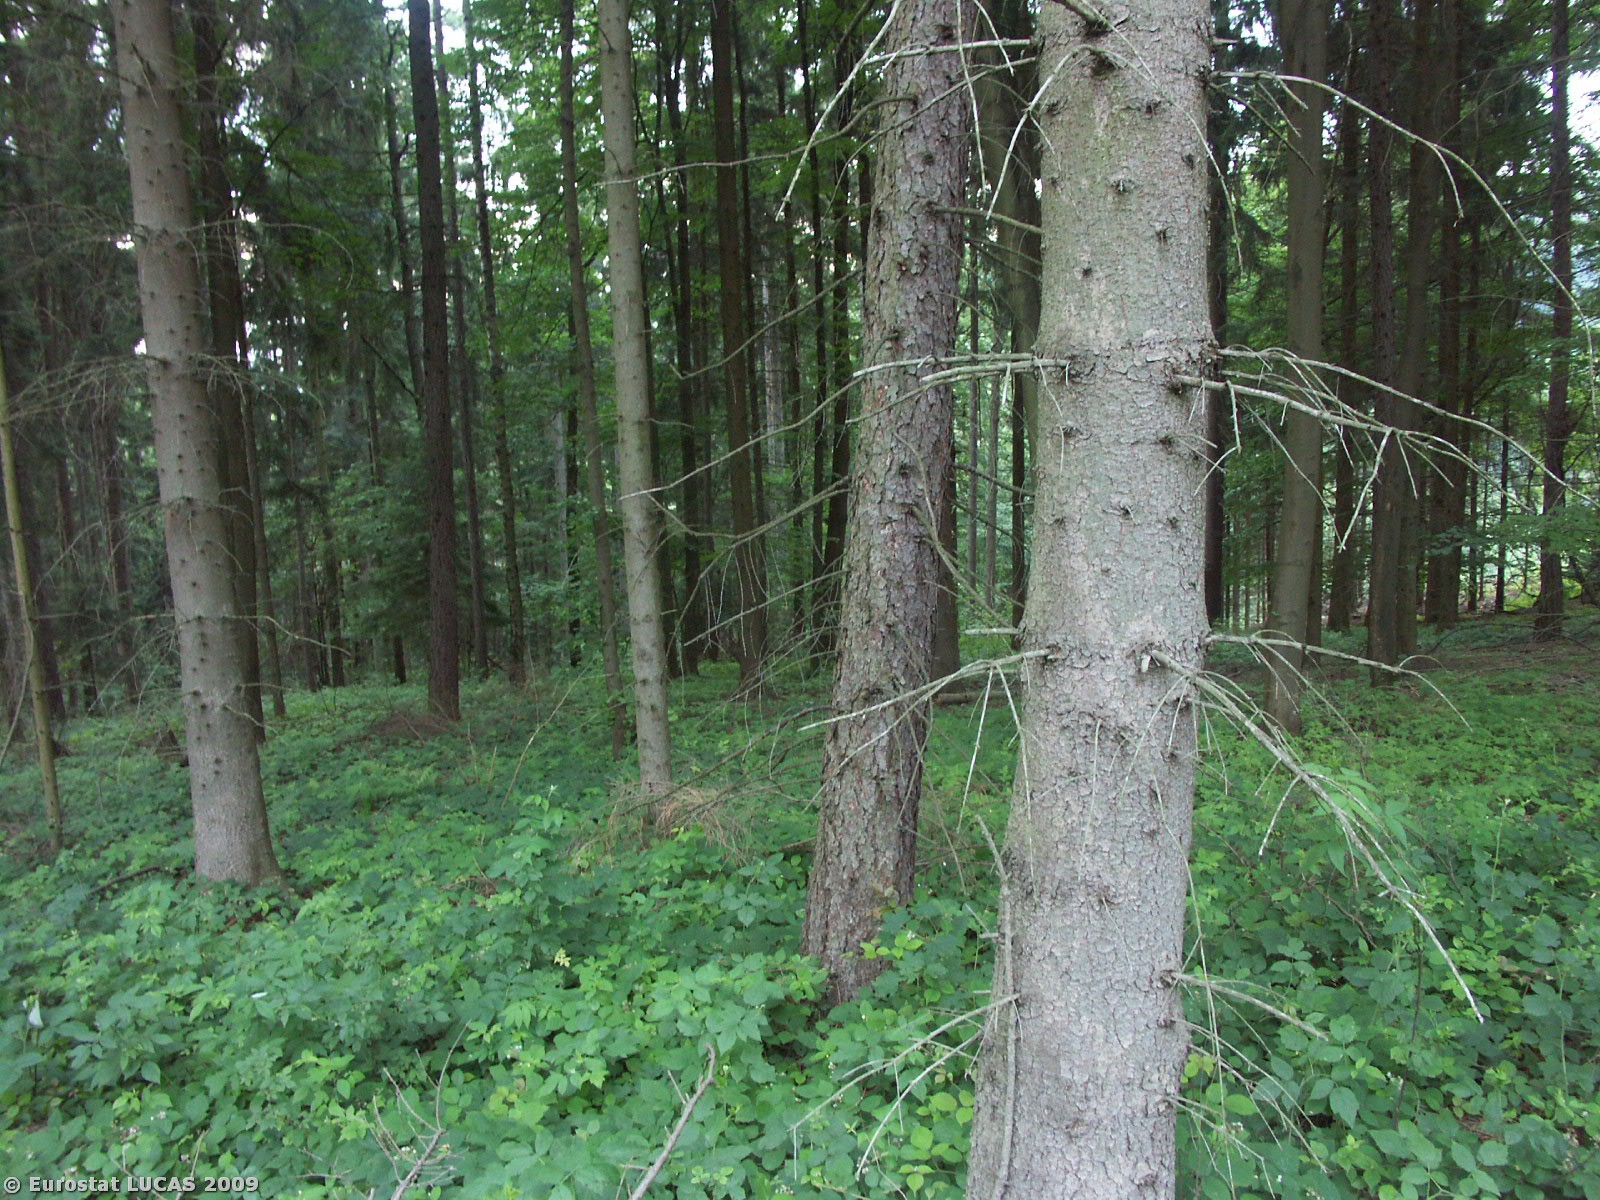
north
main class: Woodland
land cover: Coniferous woodland
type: hemiboreal forest and nemoral coniferous forest and mixed broadleaved-coniferous forest
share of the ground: > 75 %
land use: Forestry
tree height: > 5 m
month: July
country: CZ
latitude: 49.9357
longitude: 16.6539
